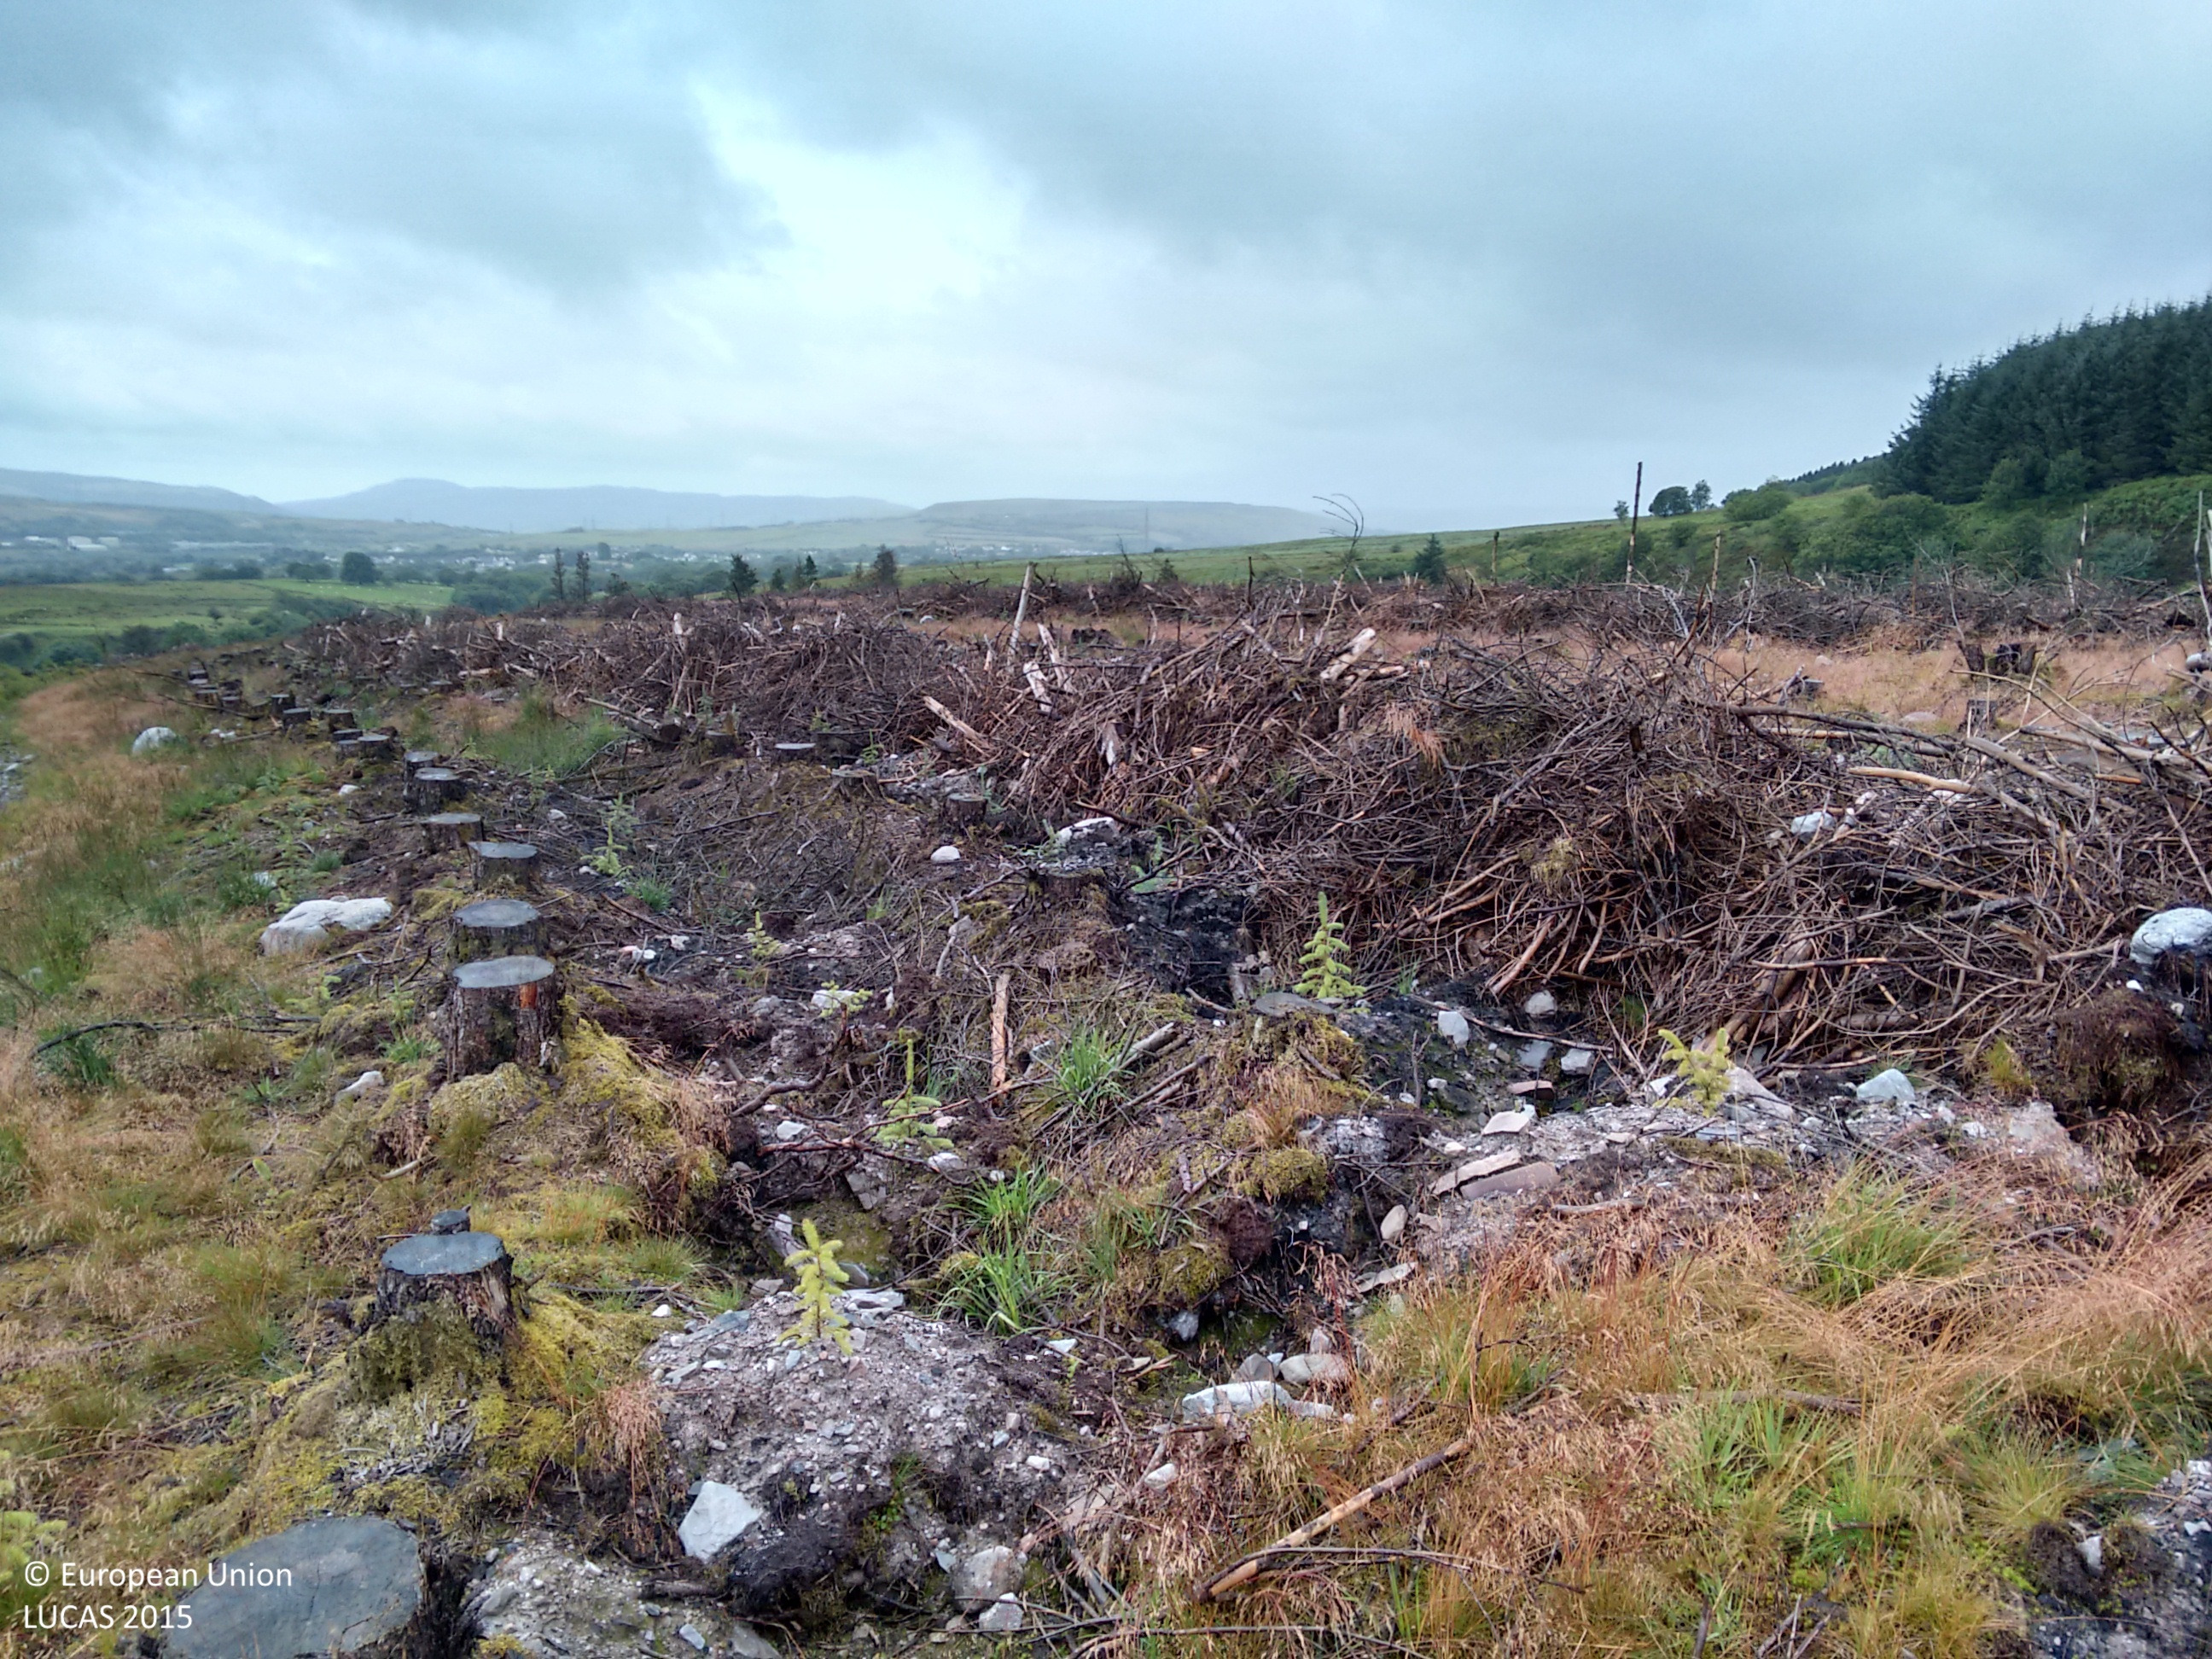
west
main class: Grassland
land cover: Spontaneously vegetated surfaces
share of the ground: > 75 %
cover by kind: herbaceous plants 70 %, unconsolidated bare surface 30 %
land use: Forestry
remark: Clear cut
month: July
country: GB
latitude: 51.8034
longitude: -3.6470
